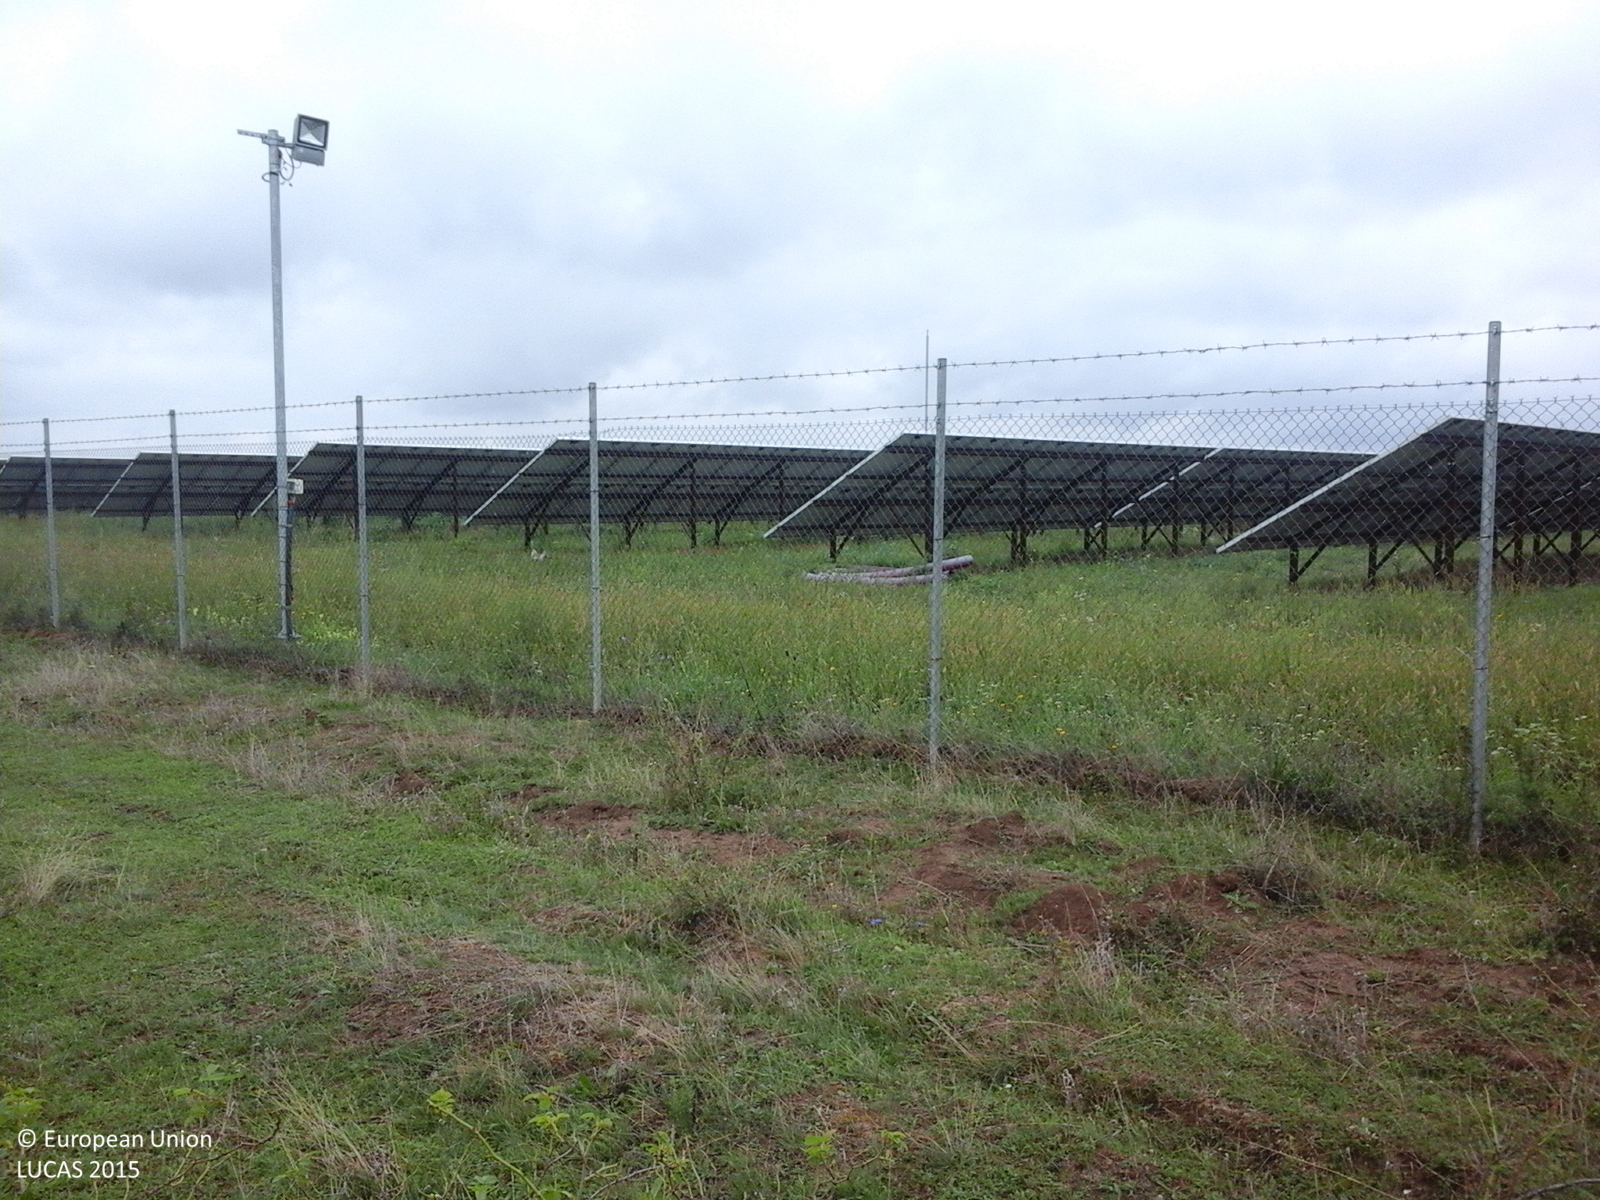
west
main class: Artificial land
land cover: Non built-up area features
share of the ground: 50 - 75 %
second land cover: Grassland without tree/shrub cover
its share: > 75 %
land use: Energy production
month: September
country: RO
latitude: 46.9298
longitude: 21.8254
